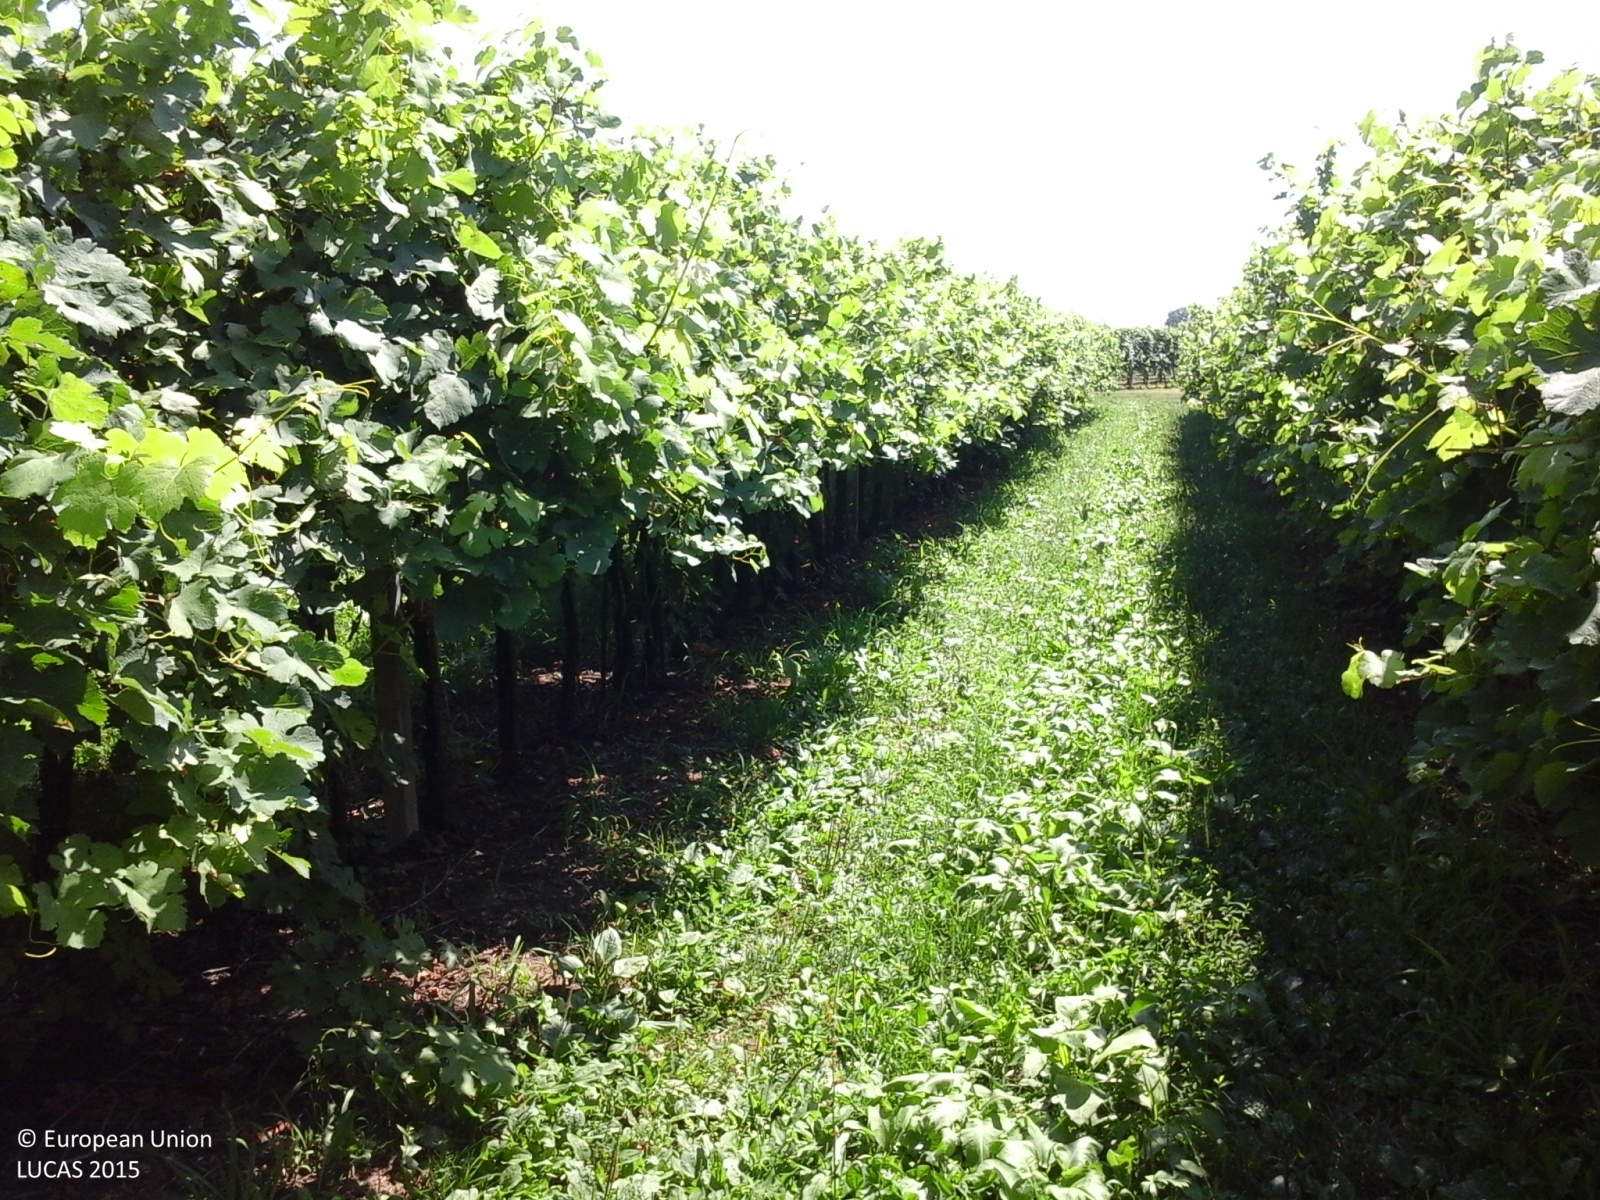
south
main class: Cropland
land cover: Vineyards
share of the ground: 25 - 50 %
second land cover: Grassland without tree/shrub cover
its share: > 75 %
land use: Agriculture (excluding fallow land and kitchen gardens)
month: July
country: IT
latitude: 45.8038
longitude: 12.3000
